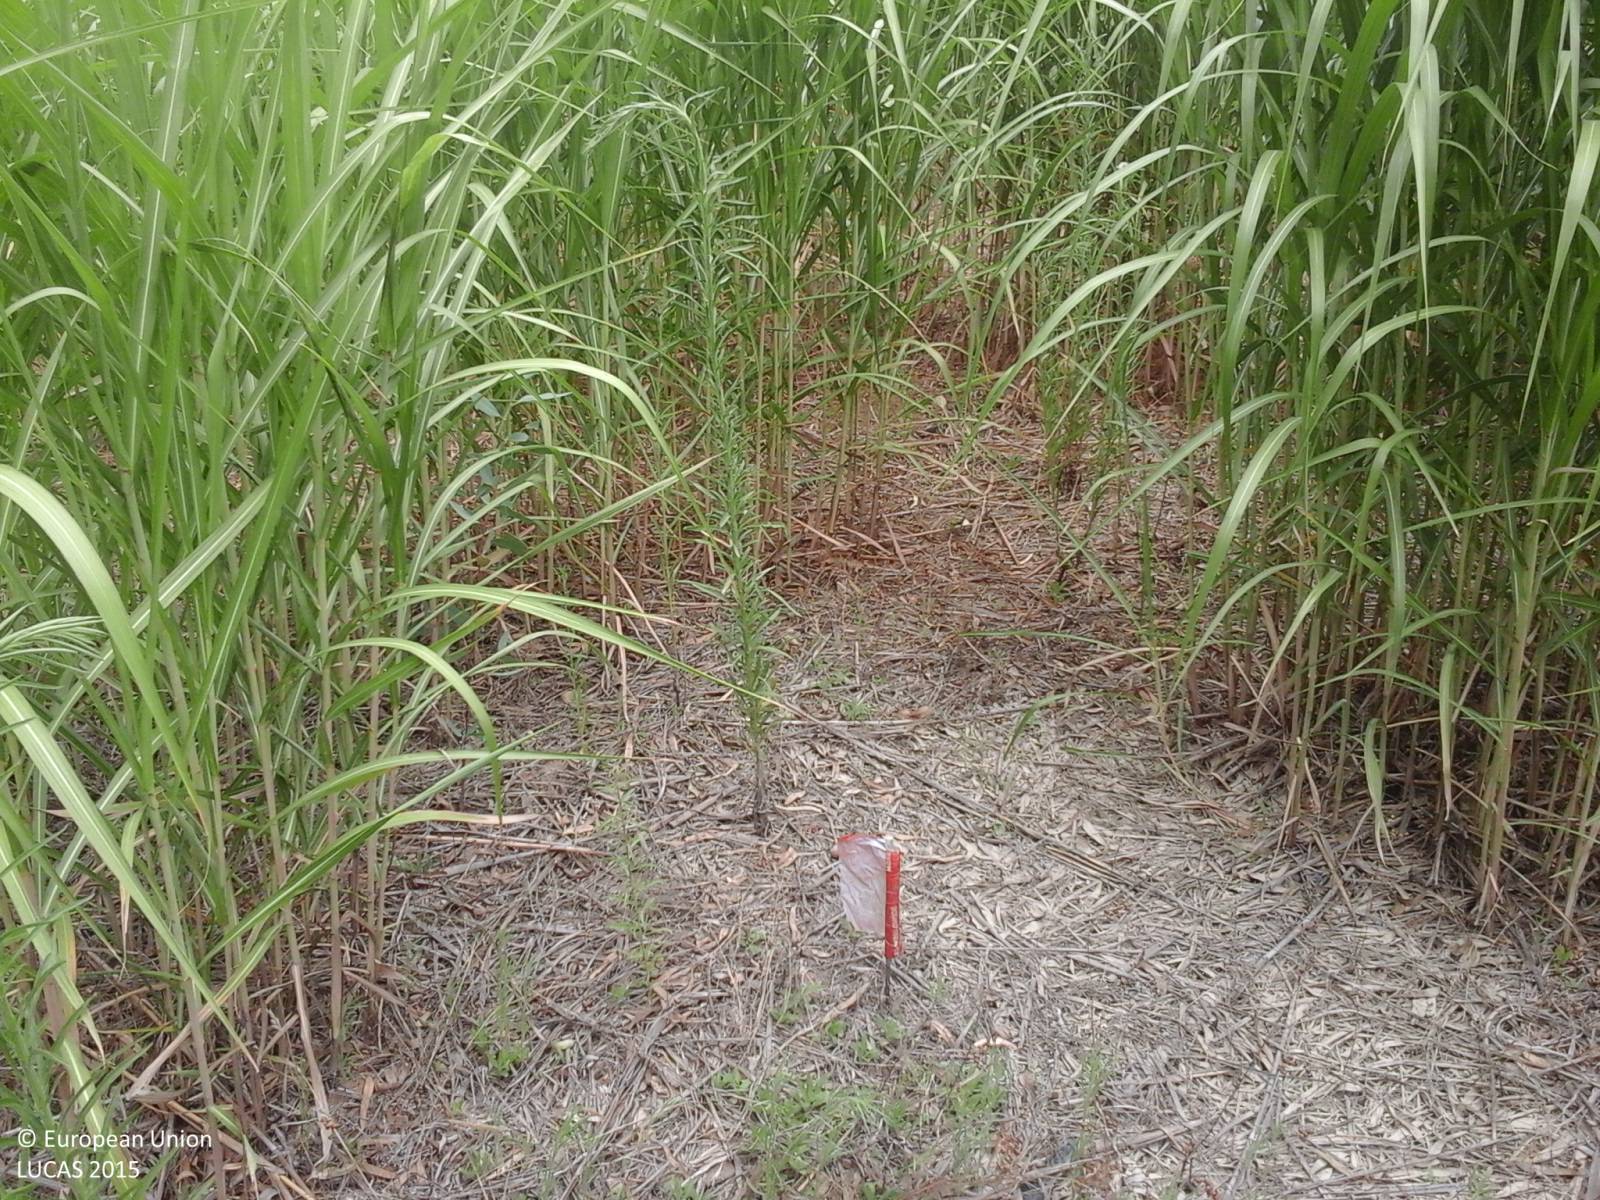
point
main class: Cropland
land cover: Permanent industrial crops
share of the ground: > 75 %
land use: Agriculture (excluding fallow land and kitchen gardens)
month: July
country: IT
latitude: 39.4638
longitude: 8.8562
